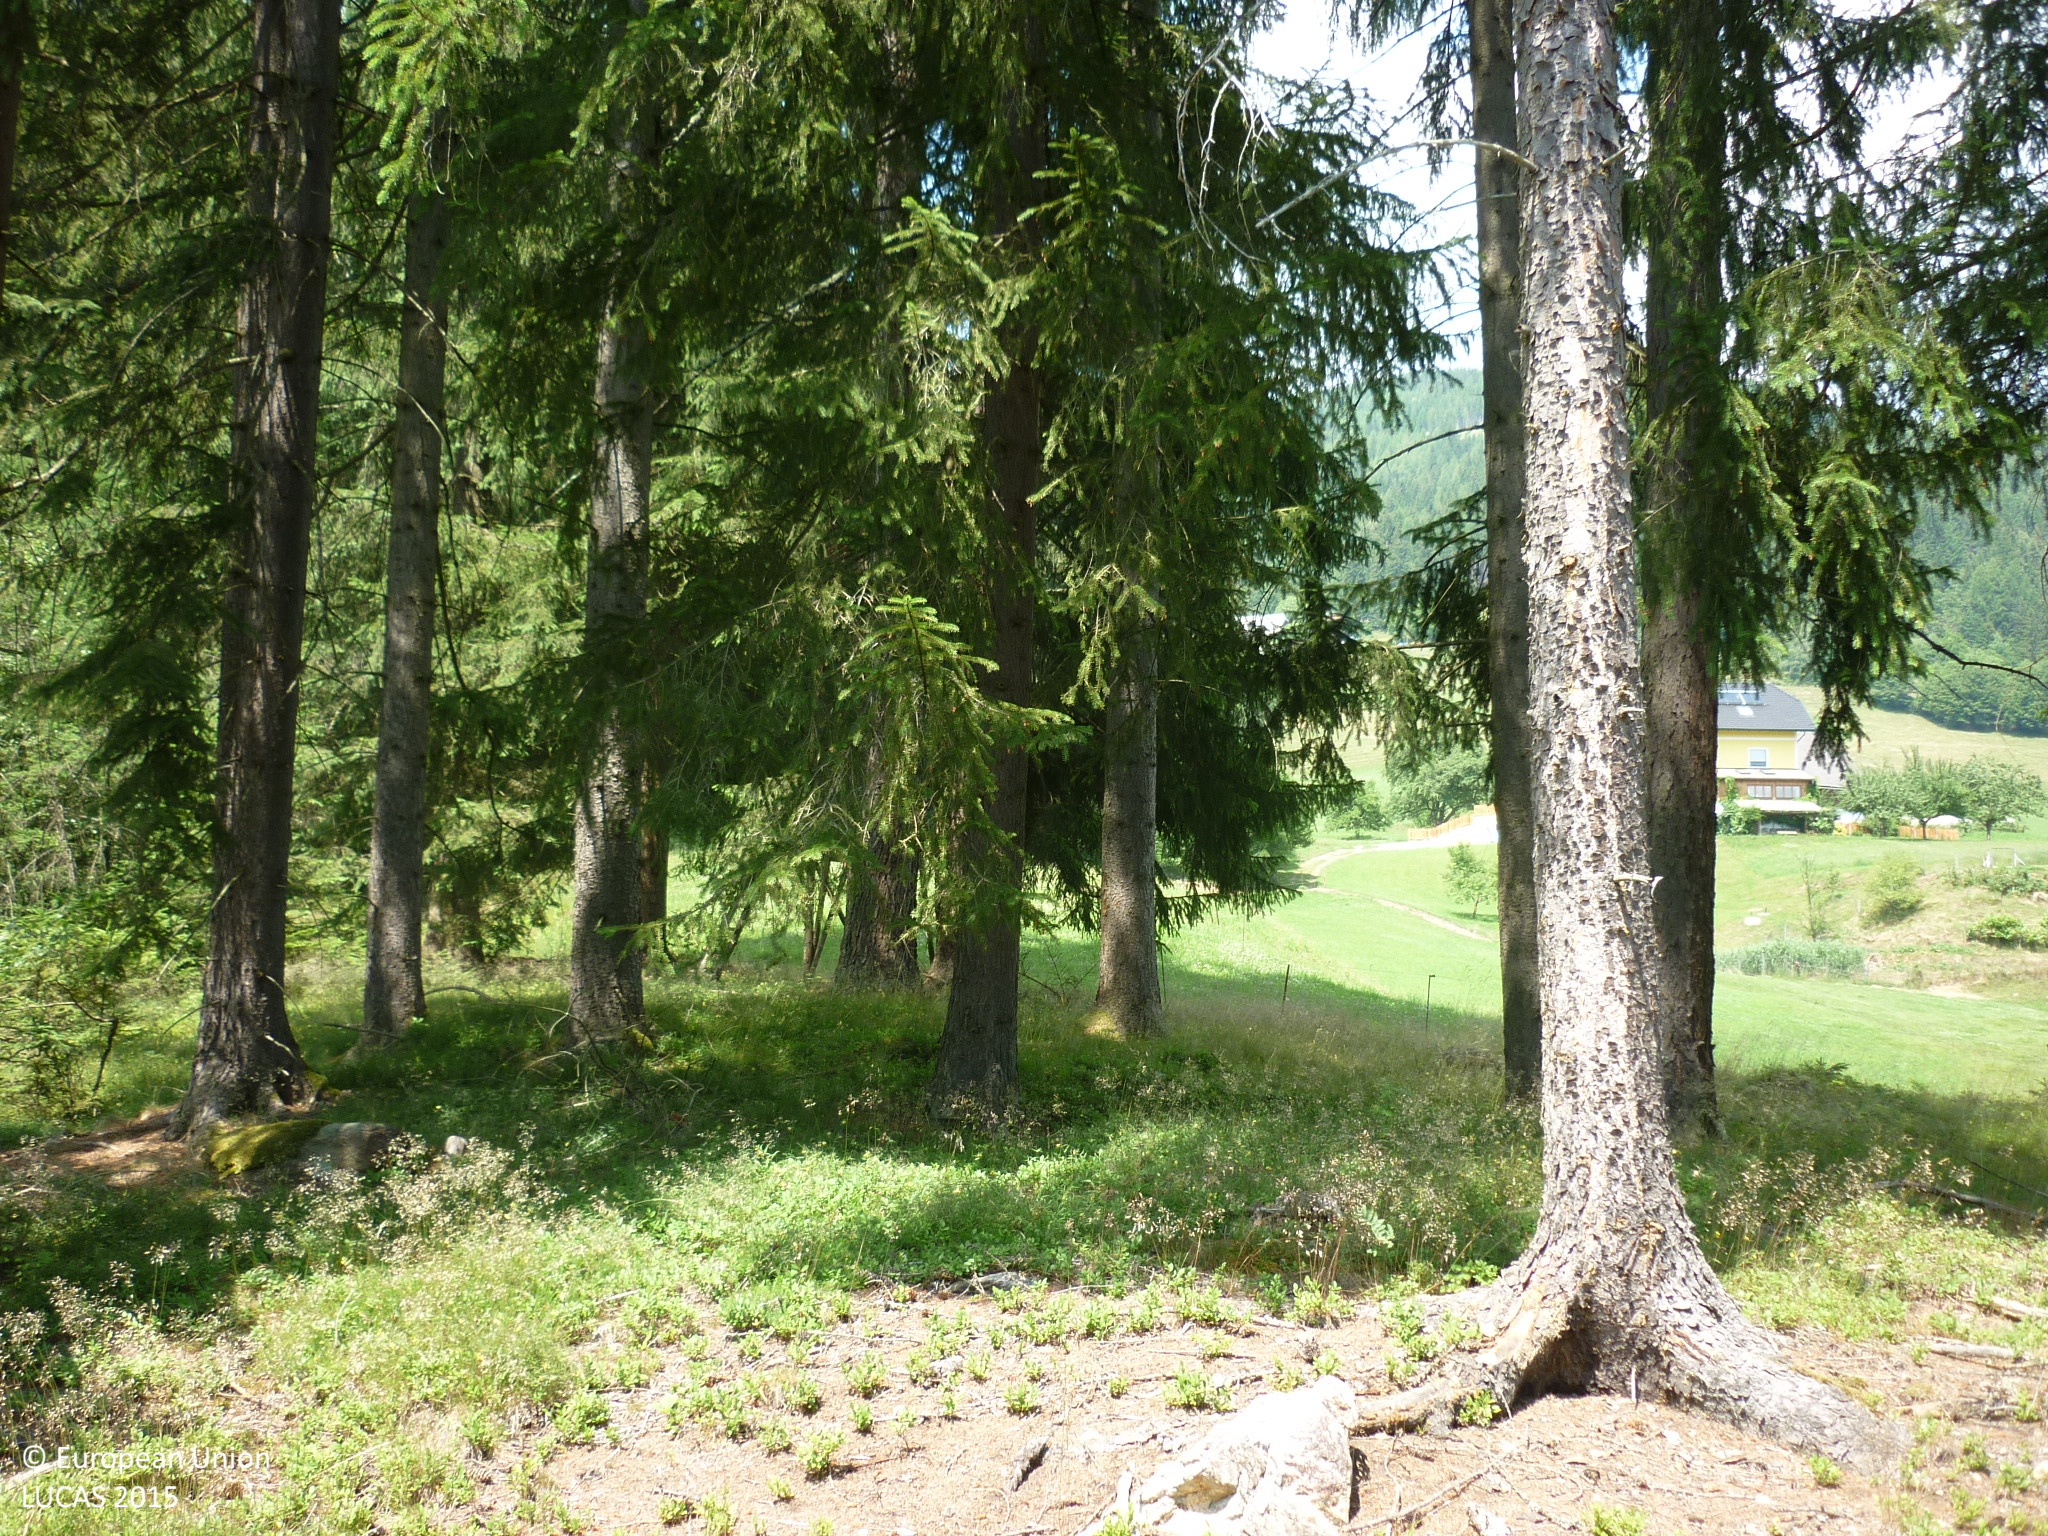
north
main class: Woodland
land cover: Spruce dominated coniferous woodland
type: alpine coniferous forest
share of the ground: 50 - 75 %
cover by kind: coniferous forest trees 60 %, herbaceous plants 20 %, lichens and mosses 20 %
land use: Forestry
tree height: > 5 m
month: July
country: AT
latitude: 47.2886
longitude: 14.8254
